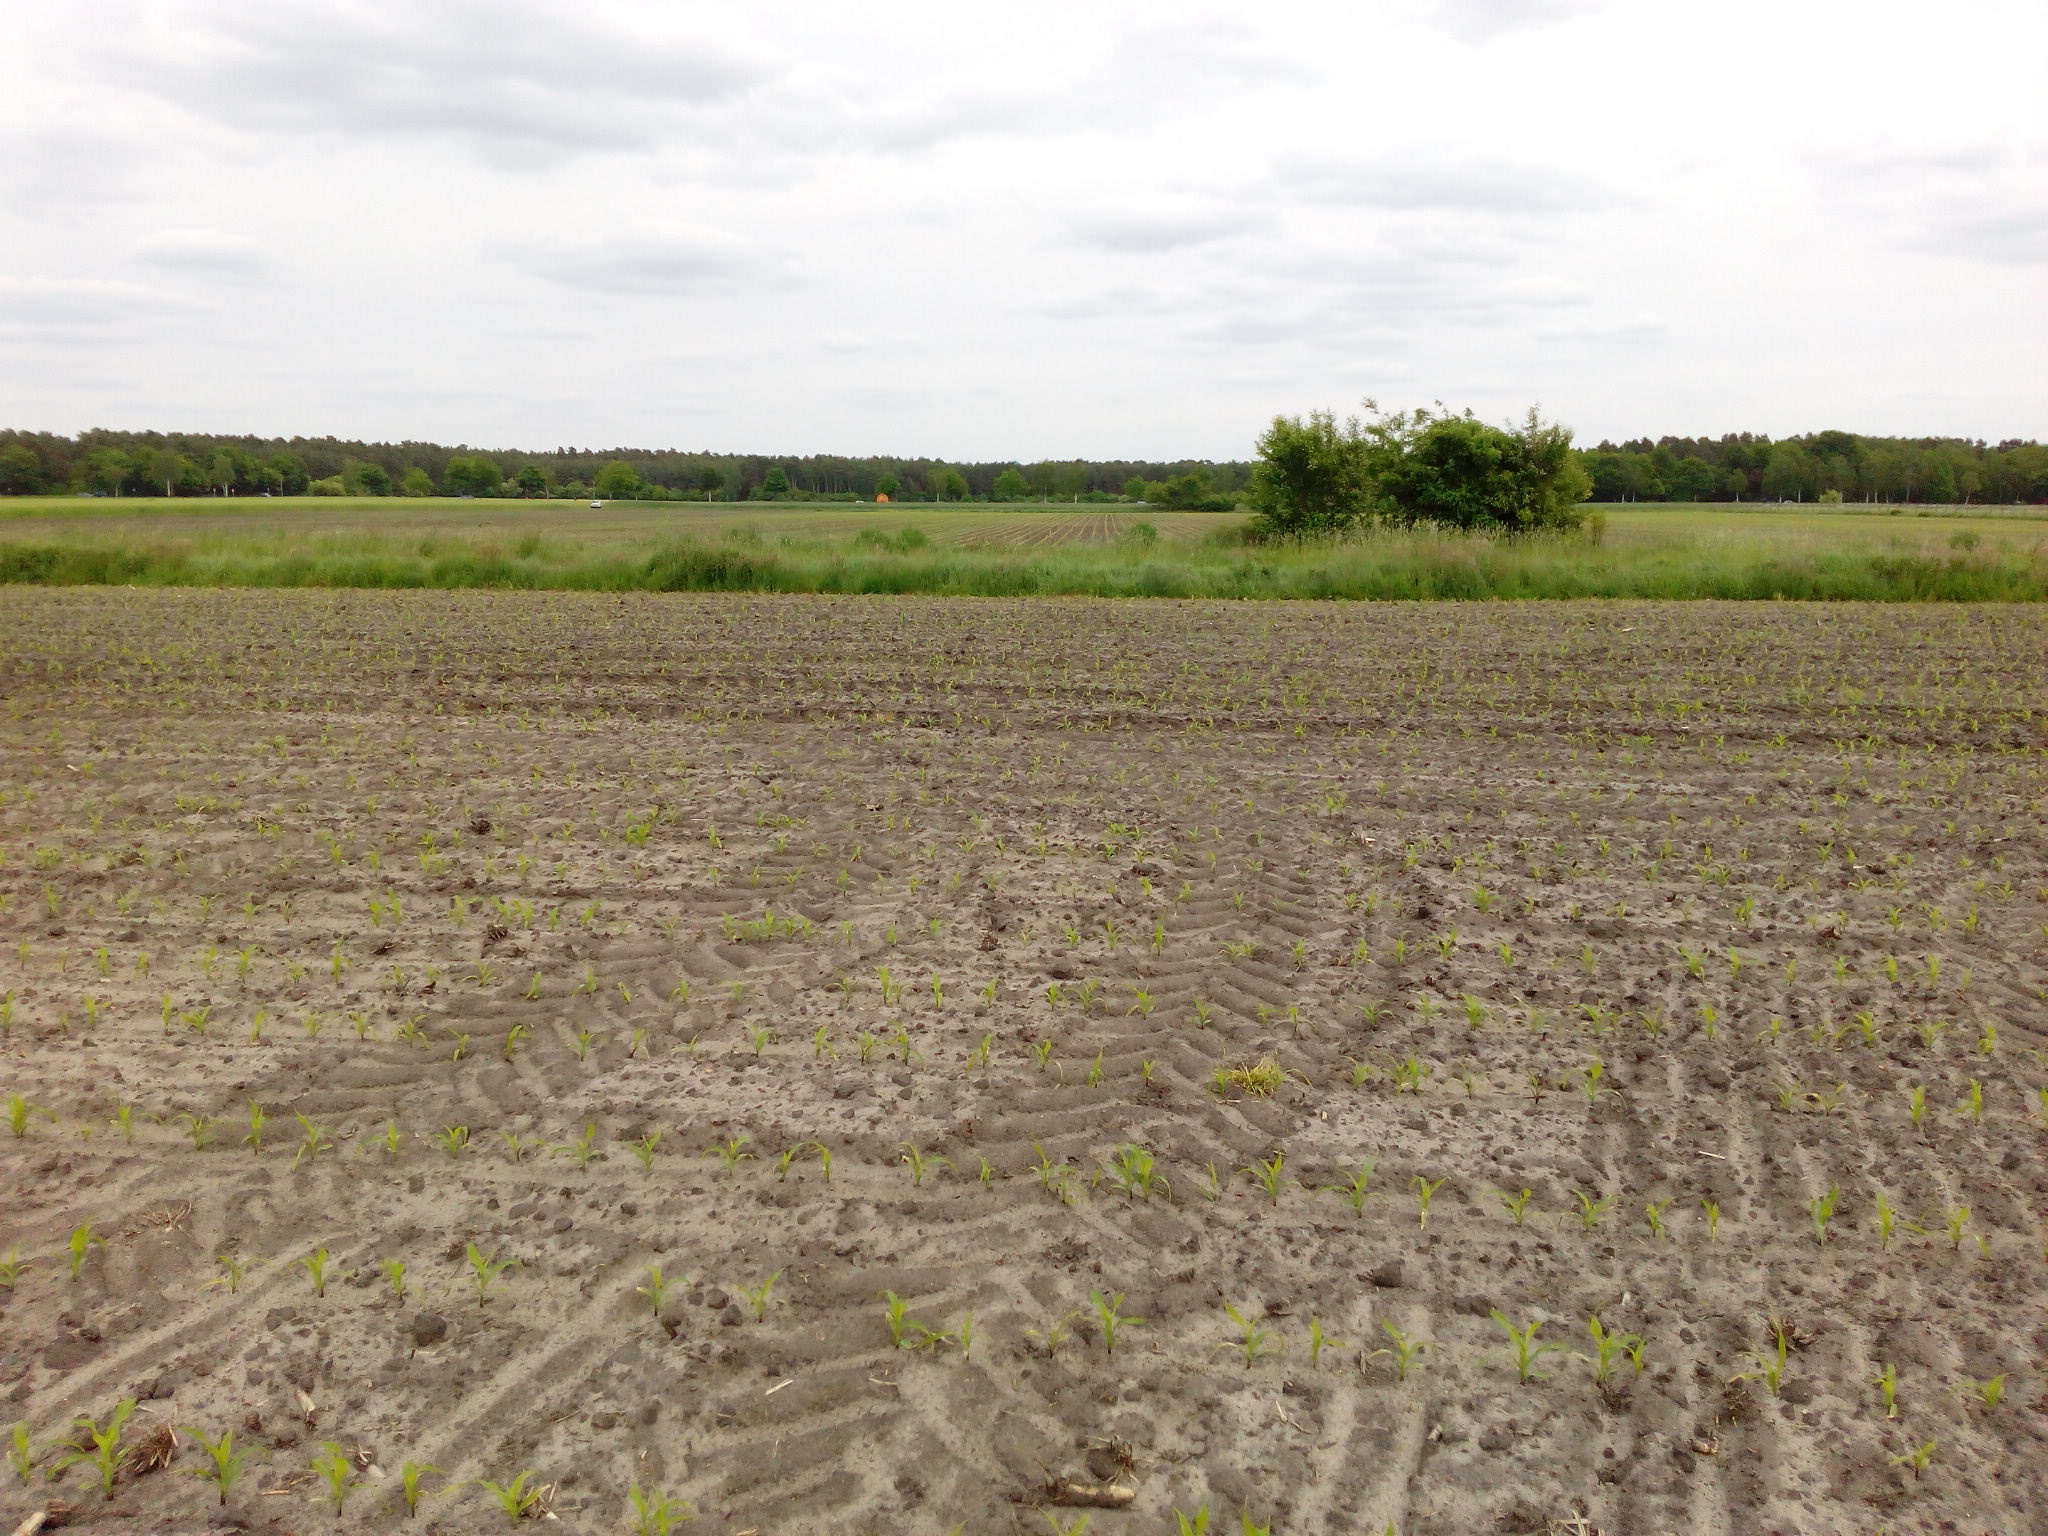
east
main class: Cropland
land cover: Maize
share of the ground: < 10 %
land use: Agriculture (excluding fallow land and kitchen gardens)
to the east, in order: Maize; Grass margins; Ditches and canals; Grass margins; Tracks; Grass margins; Ditches and canals; Grass margins; Maize
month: June
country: DE
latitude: 52.6470
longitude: 9.9261
